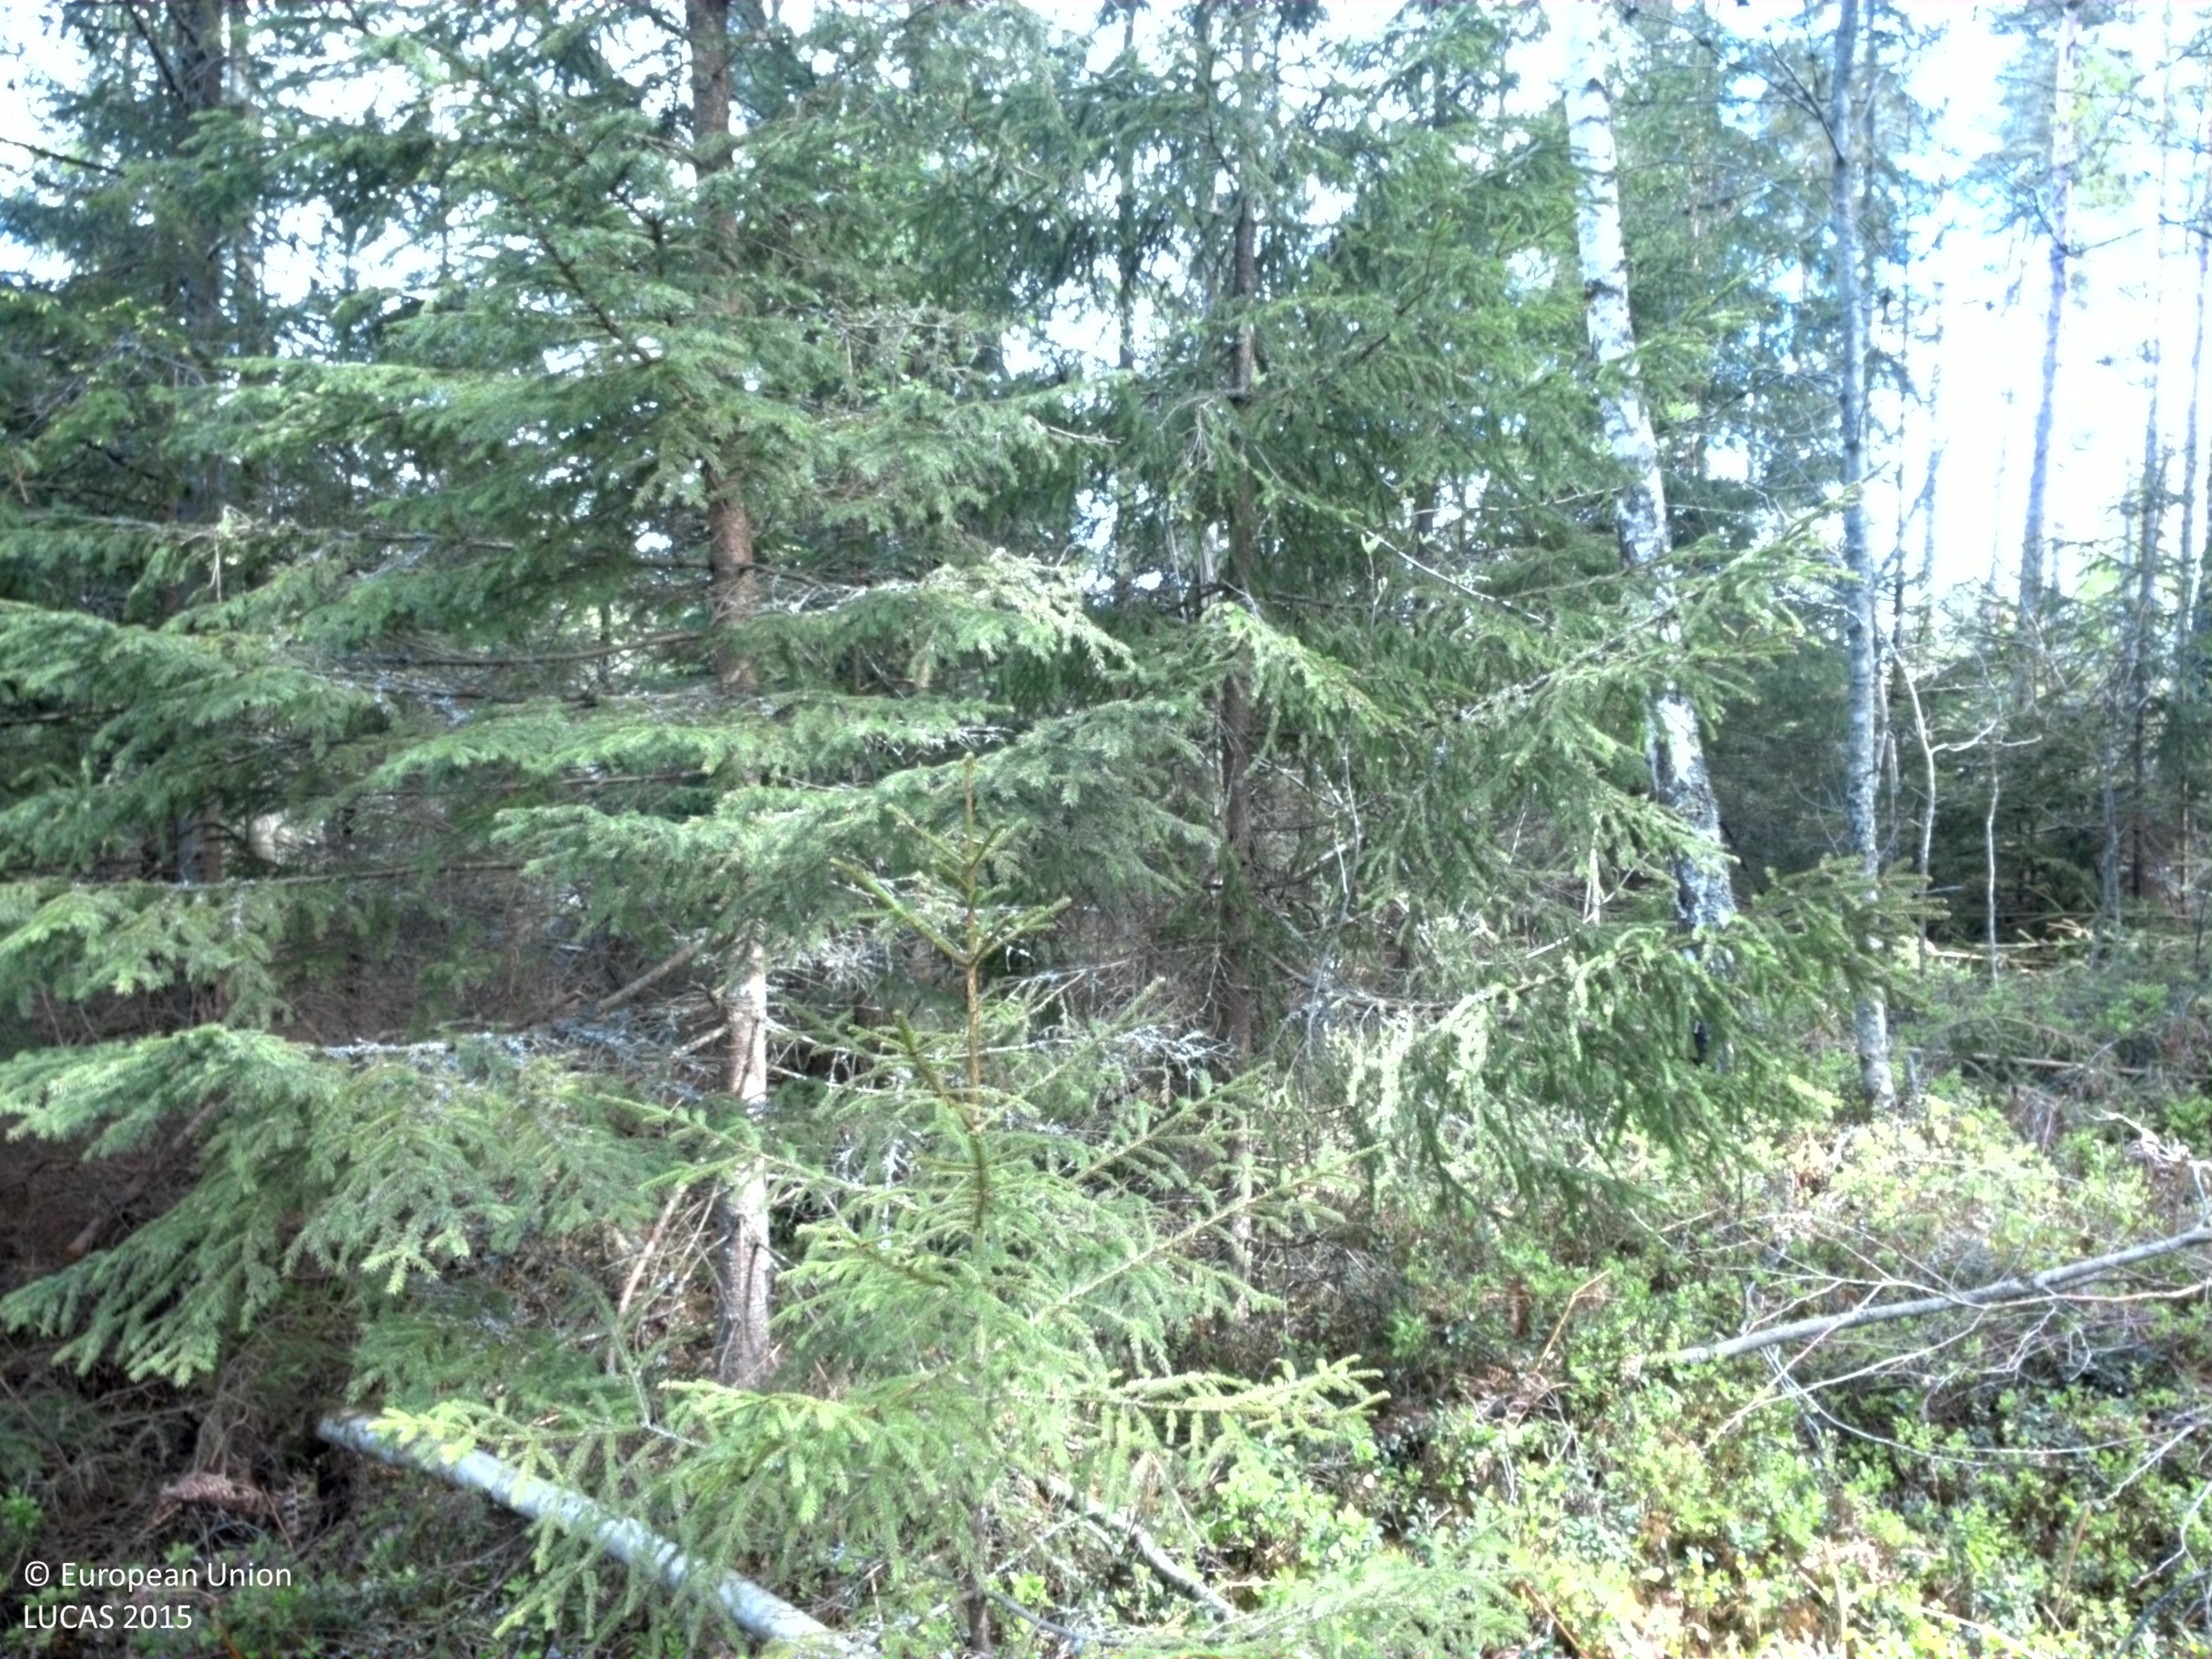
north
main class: Woodland
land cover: Pine dominated coniferous woodland
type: boreal forest
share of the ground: > 75 %
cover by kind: coniferous forest trees 60 %, broadleaved forest trees 20 %, lichens and mosses 10 %, shrubs 5 %, herbaceous plants 5 %
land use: Forestry
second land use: Amenities, museums, leisure
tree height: > 5 m
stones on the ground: < 10 %
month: May
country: SE
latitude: 56.9095
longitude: 14.7761
